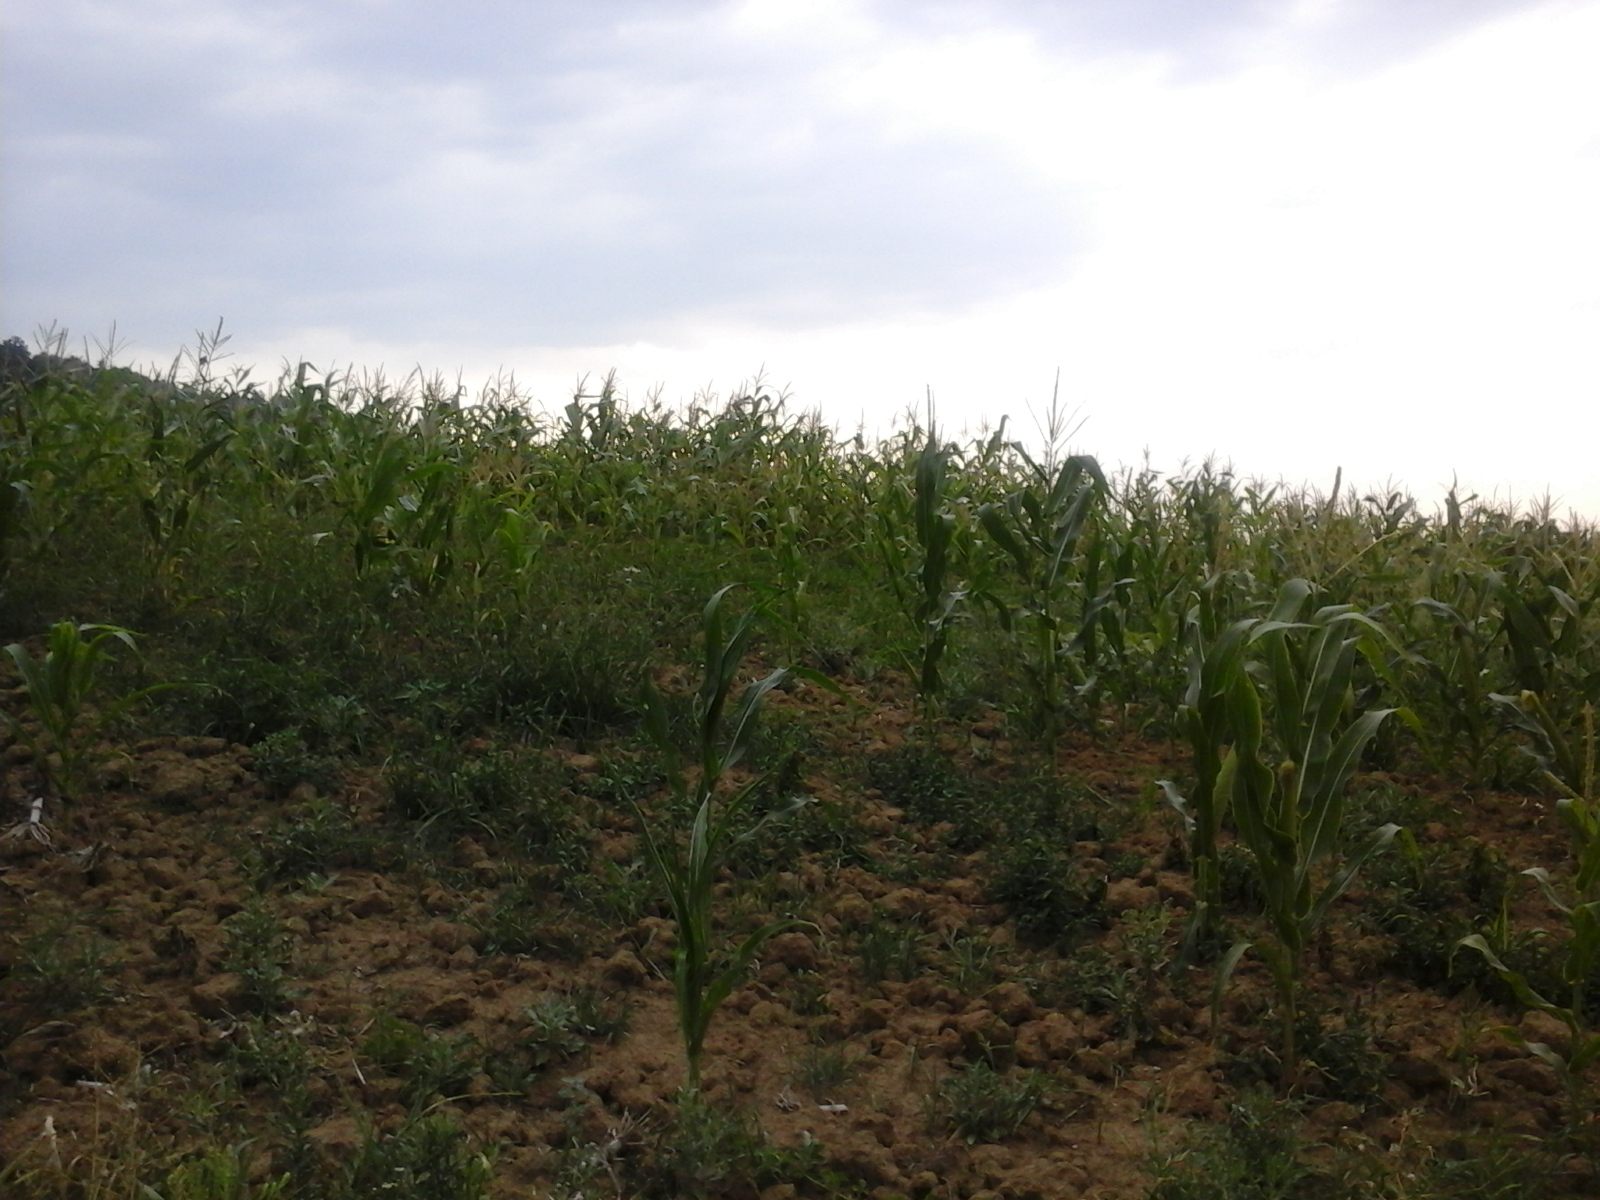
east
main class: Grassland
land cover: Spontaneously vegetated surfaces
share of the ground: > 75 %
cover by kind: herbaceous plants 100 %
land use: Agriculture (excluding fallow land and kitchen gardens)
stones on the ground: < 10 %
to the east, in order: Spontaneously vegetated surfaces; Maize; Spontaneously vegetated surfaces; Electric lines; Spontaneously vegetated surfaces; Maize; Spontaneously vegetated surfaces; Tracks; Spontaneously vegetated surfaces; Maize; Grassland without tree/shrub cover
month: August
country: RO
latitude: 44.6369
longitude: 23.3263
